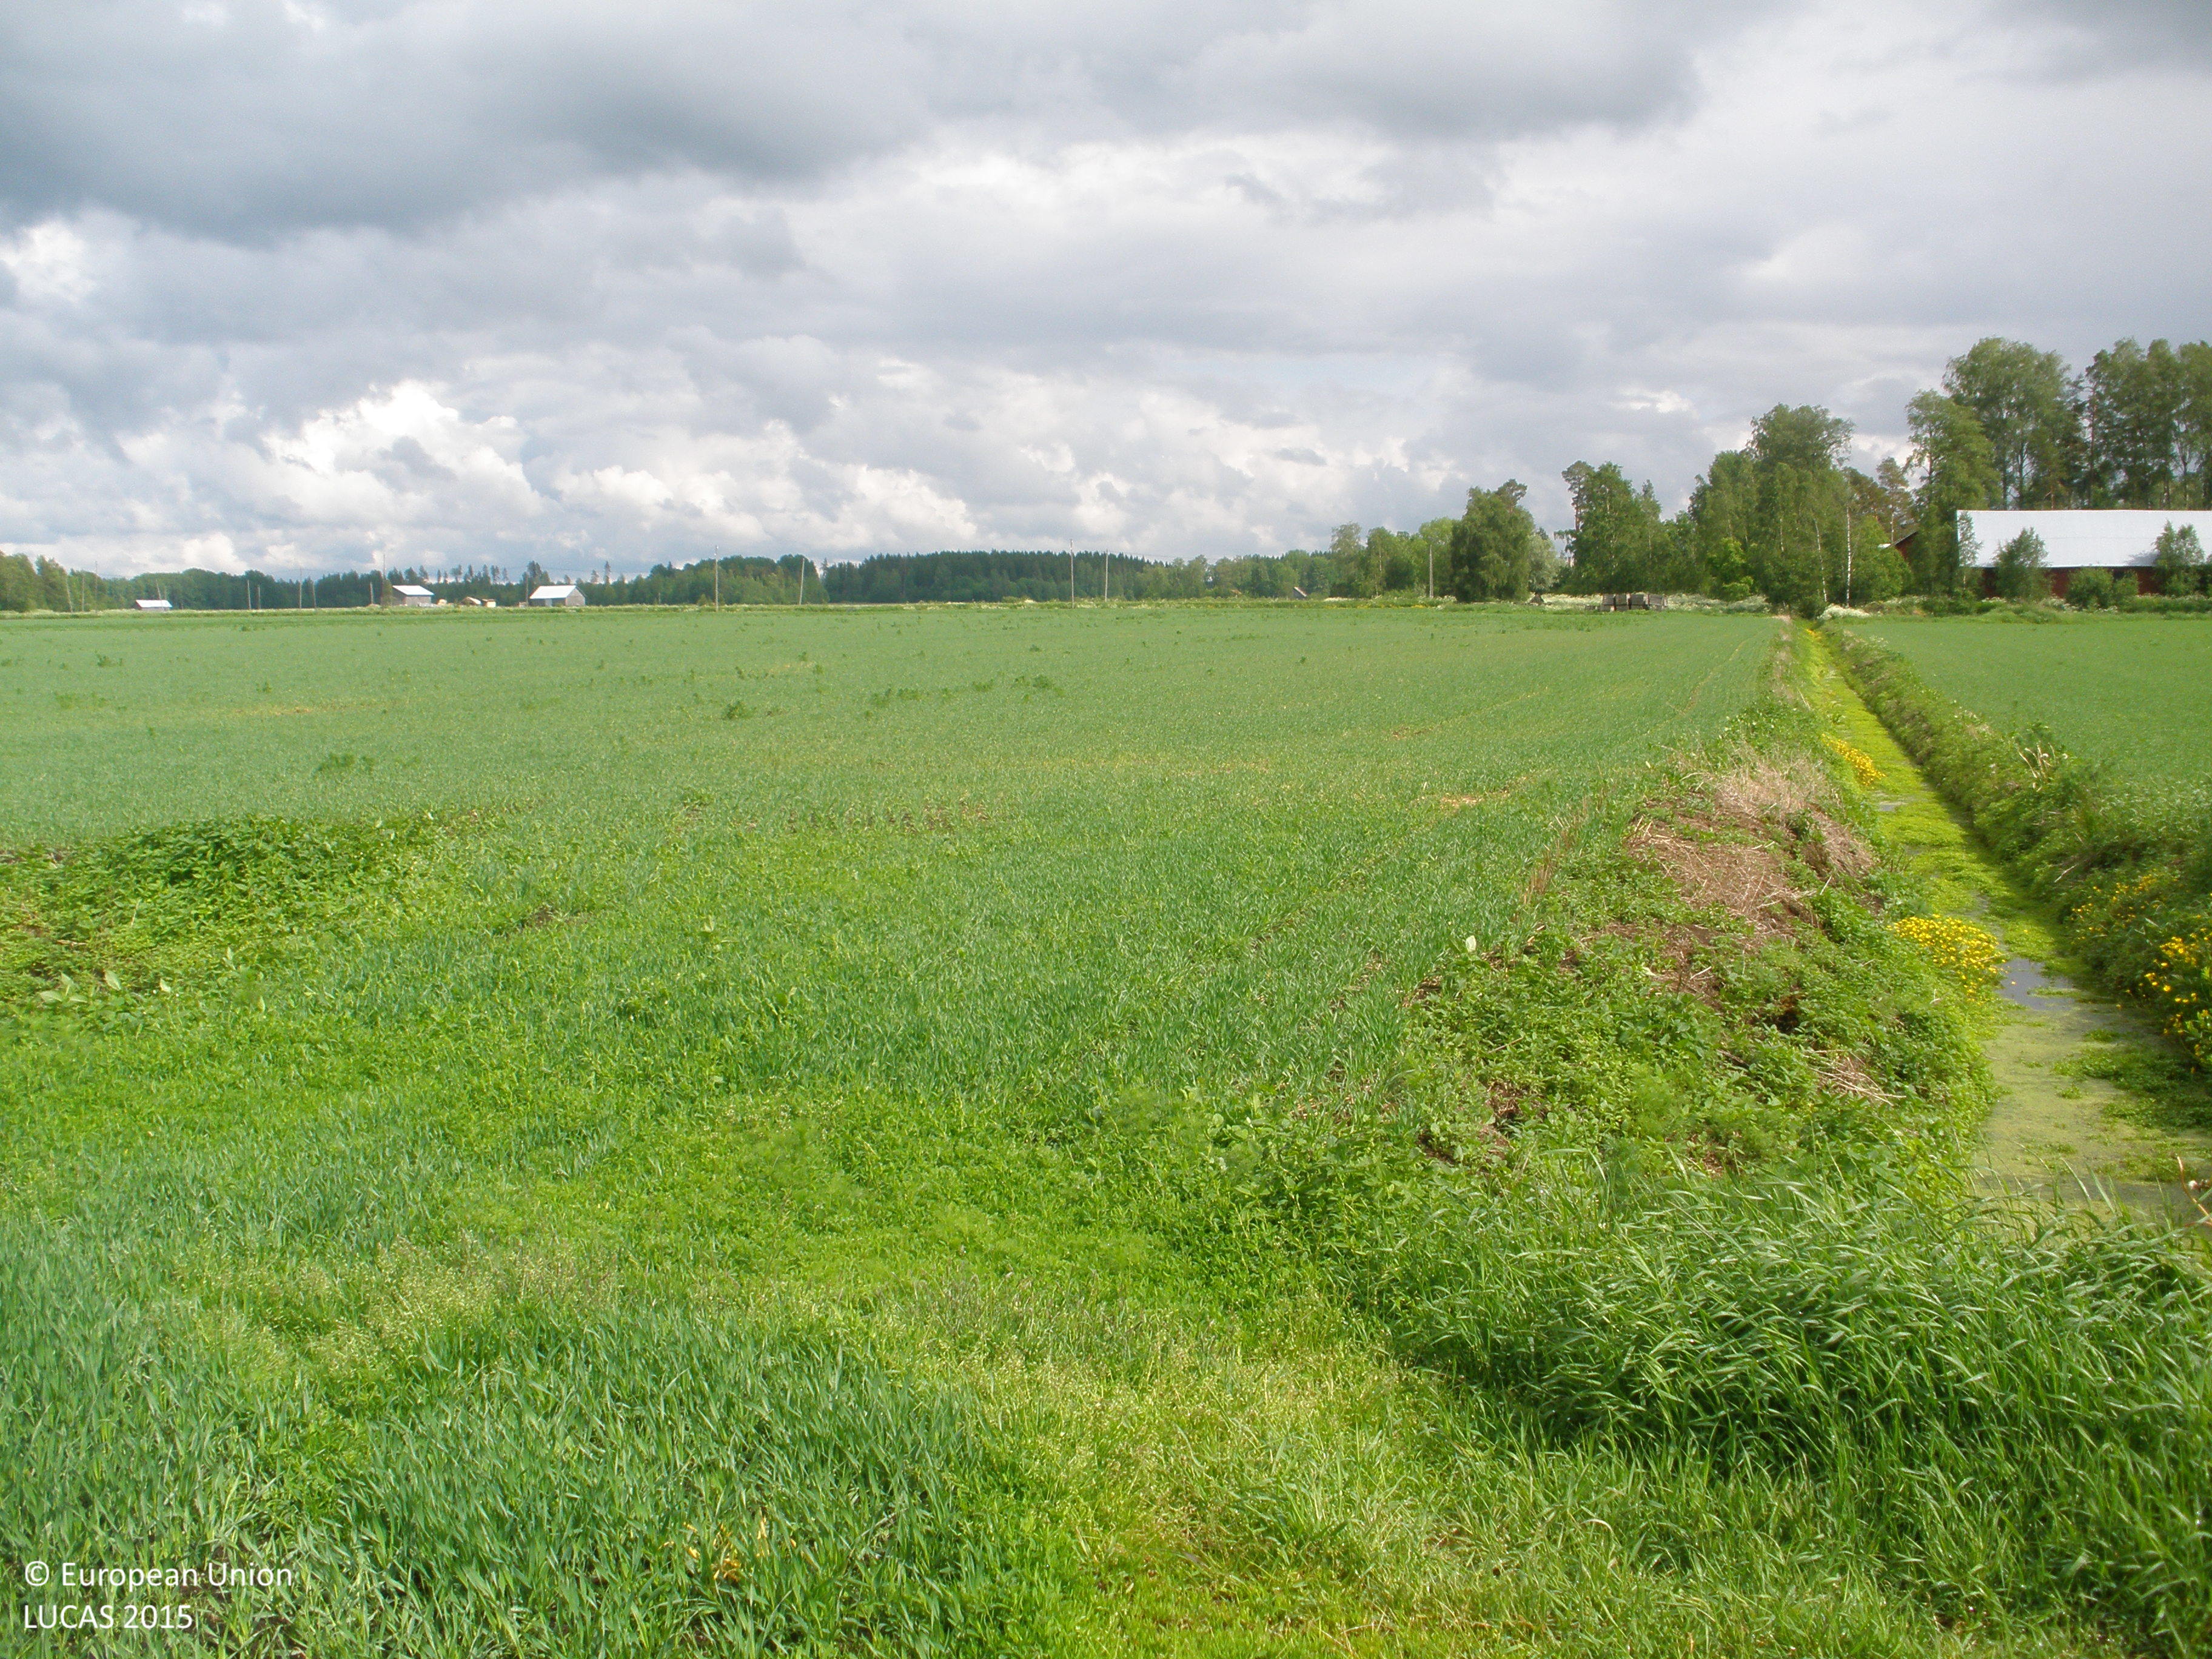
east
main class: Cropland
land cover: Barley
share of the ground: > 75 %
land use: Agriculture (excluding fallow land and kitchen gardens)
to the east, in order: Barley; Arable land (only in case pi); Ditches and canals; Arable land (only in case pi)
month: June
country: FI
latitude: 60.9517
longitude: 23.5437
